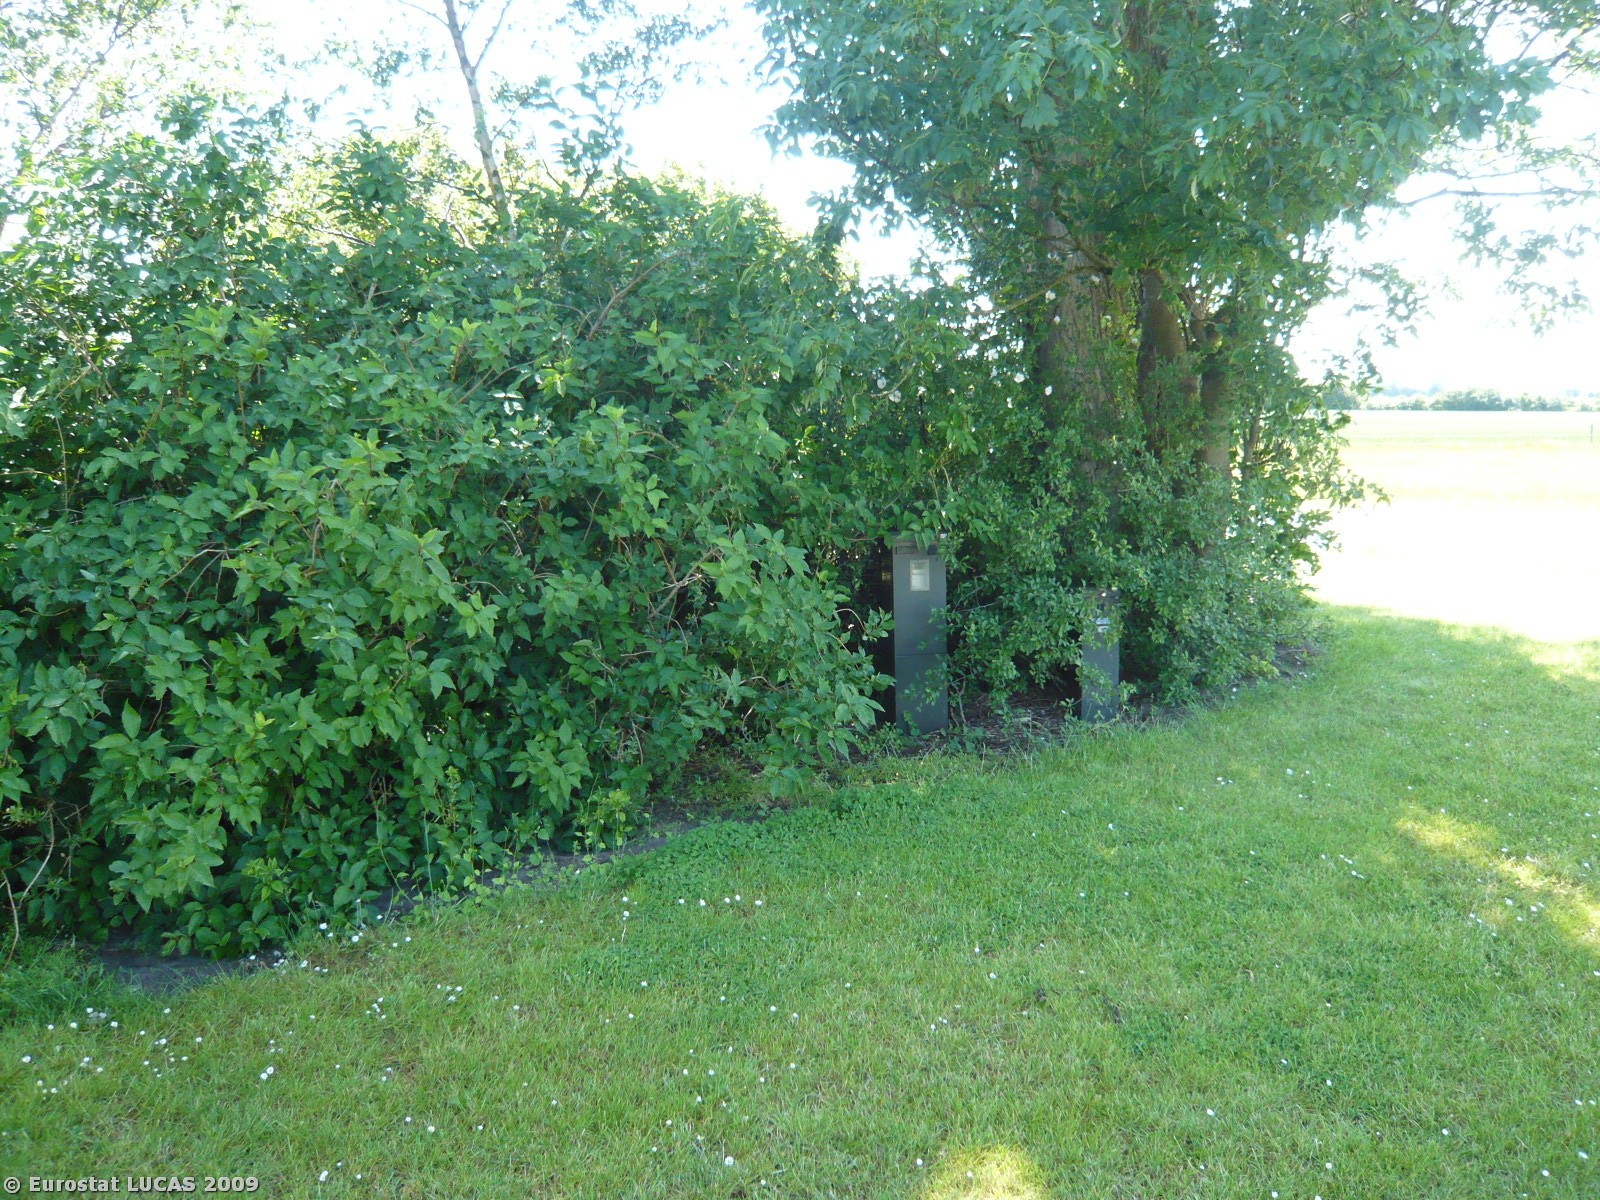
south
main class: Grassland
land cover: Grassland without tree/shrub cover
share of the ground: > 75 %
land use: Residential
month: June
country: DK
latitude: 54.7950
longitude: 11.4766
